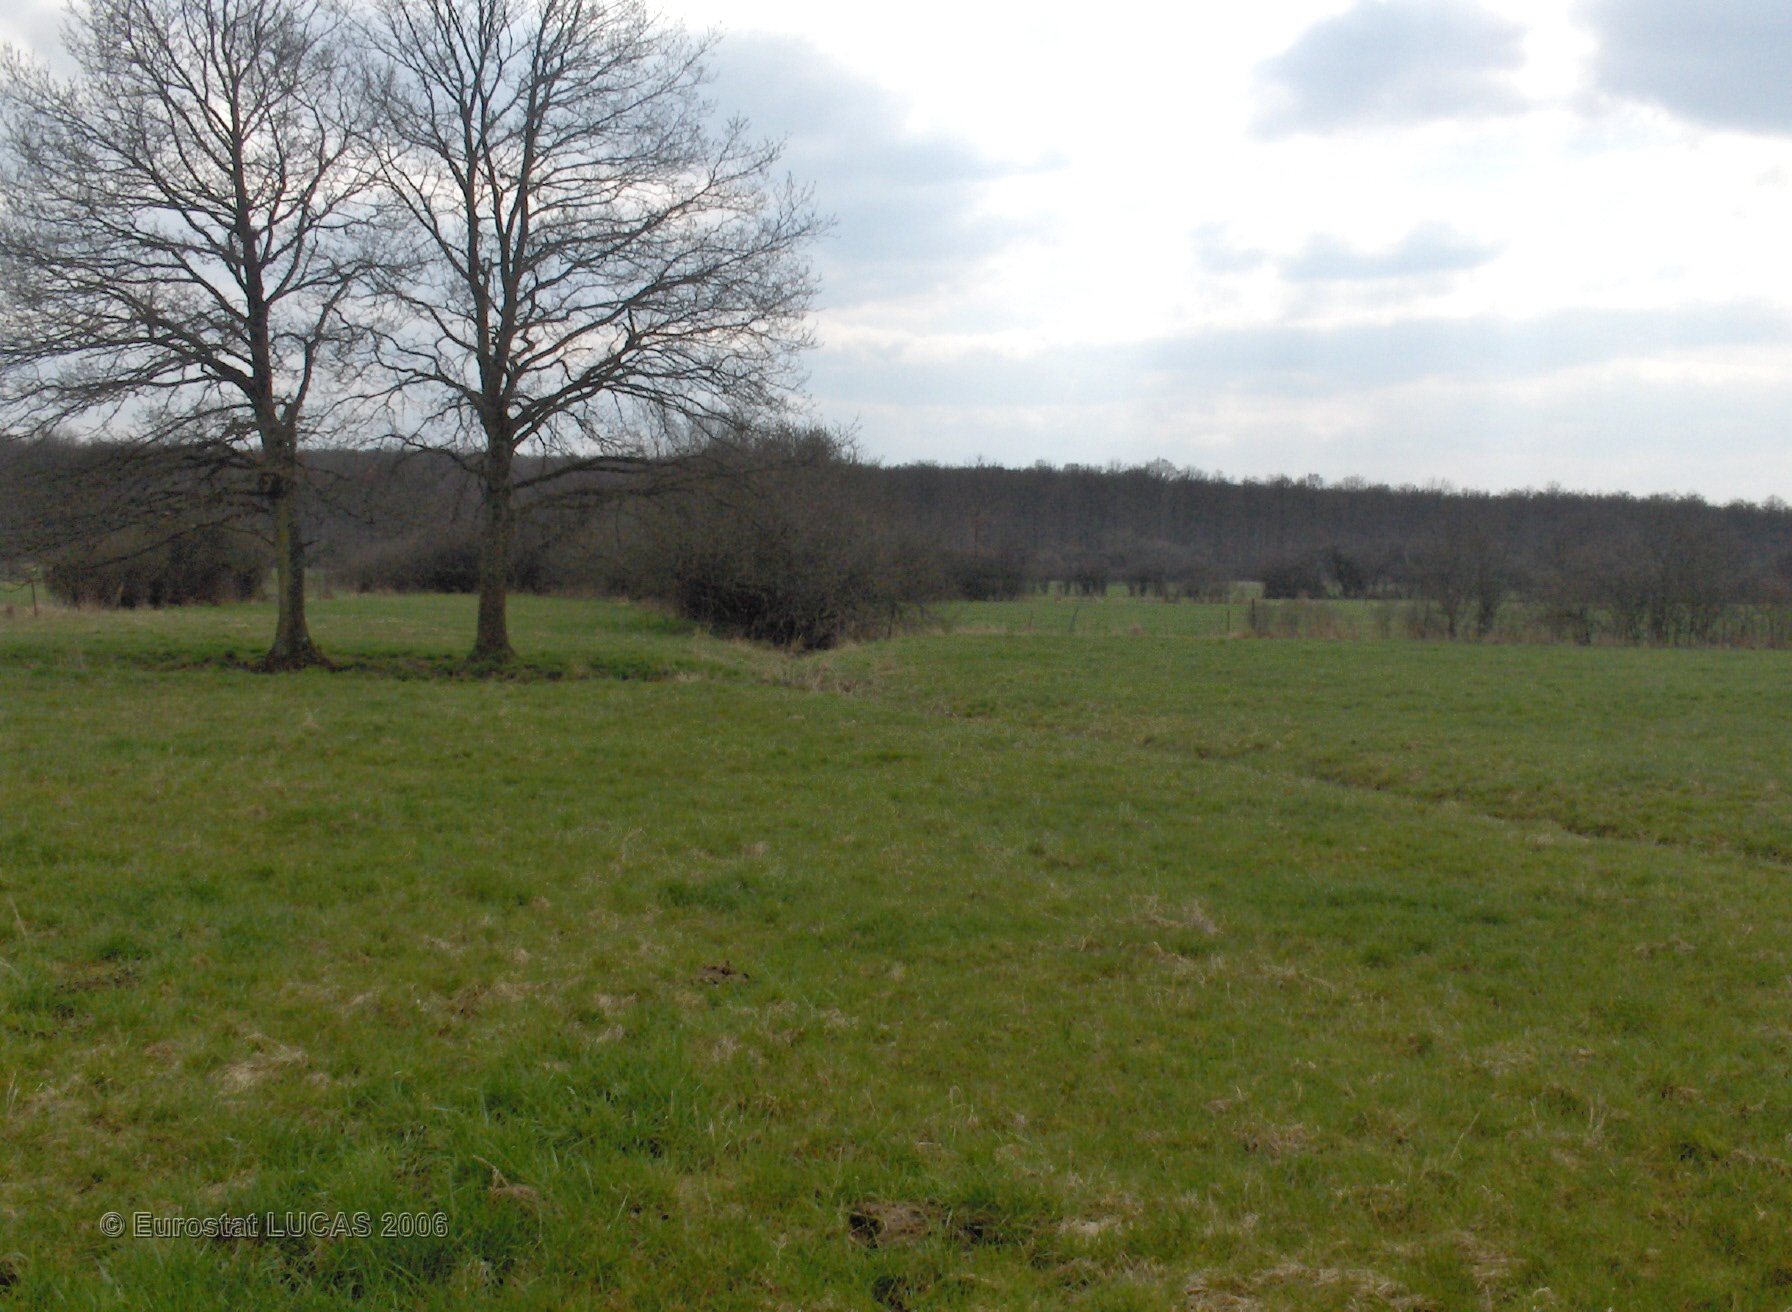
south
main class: Grassland
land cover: Grassland without tree/shrub cover
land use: Agriculture (excluding fallow land and kitchen gardens)
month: April
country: BE
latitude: 50.1263
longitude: 4.5548
